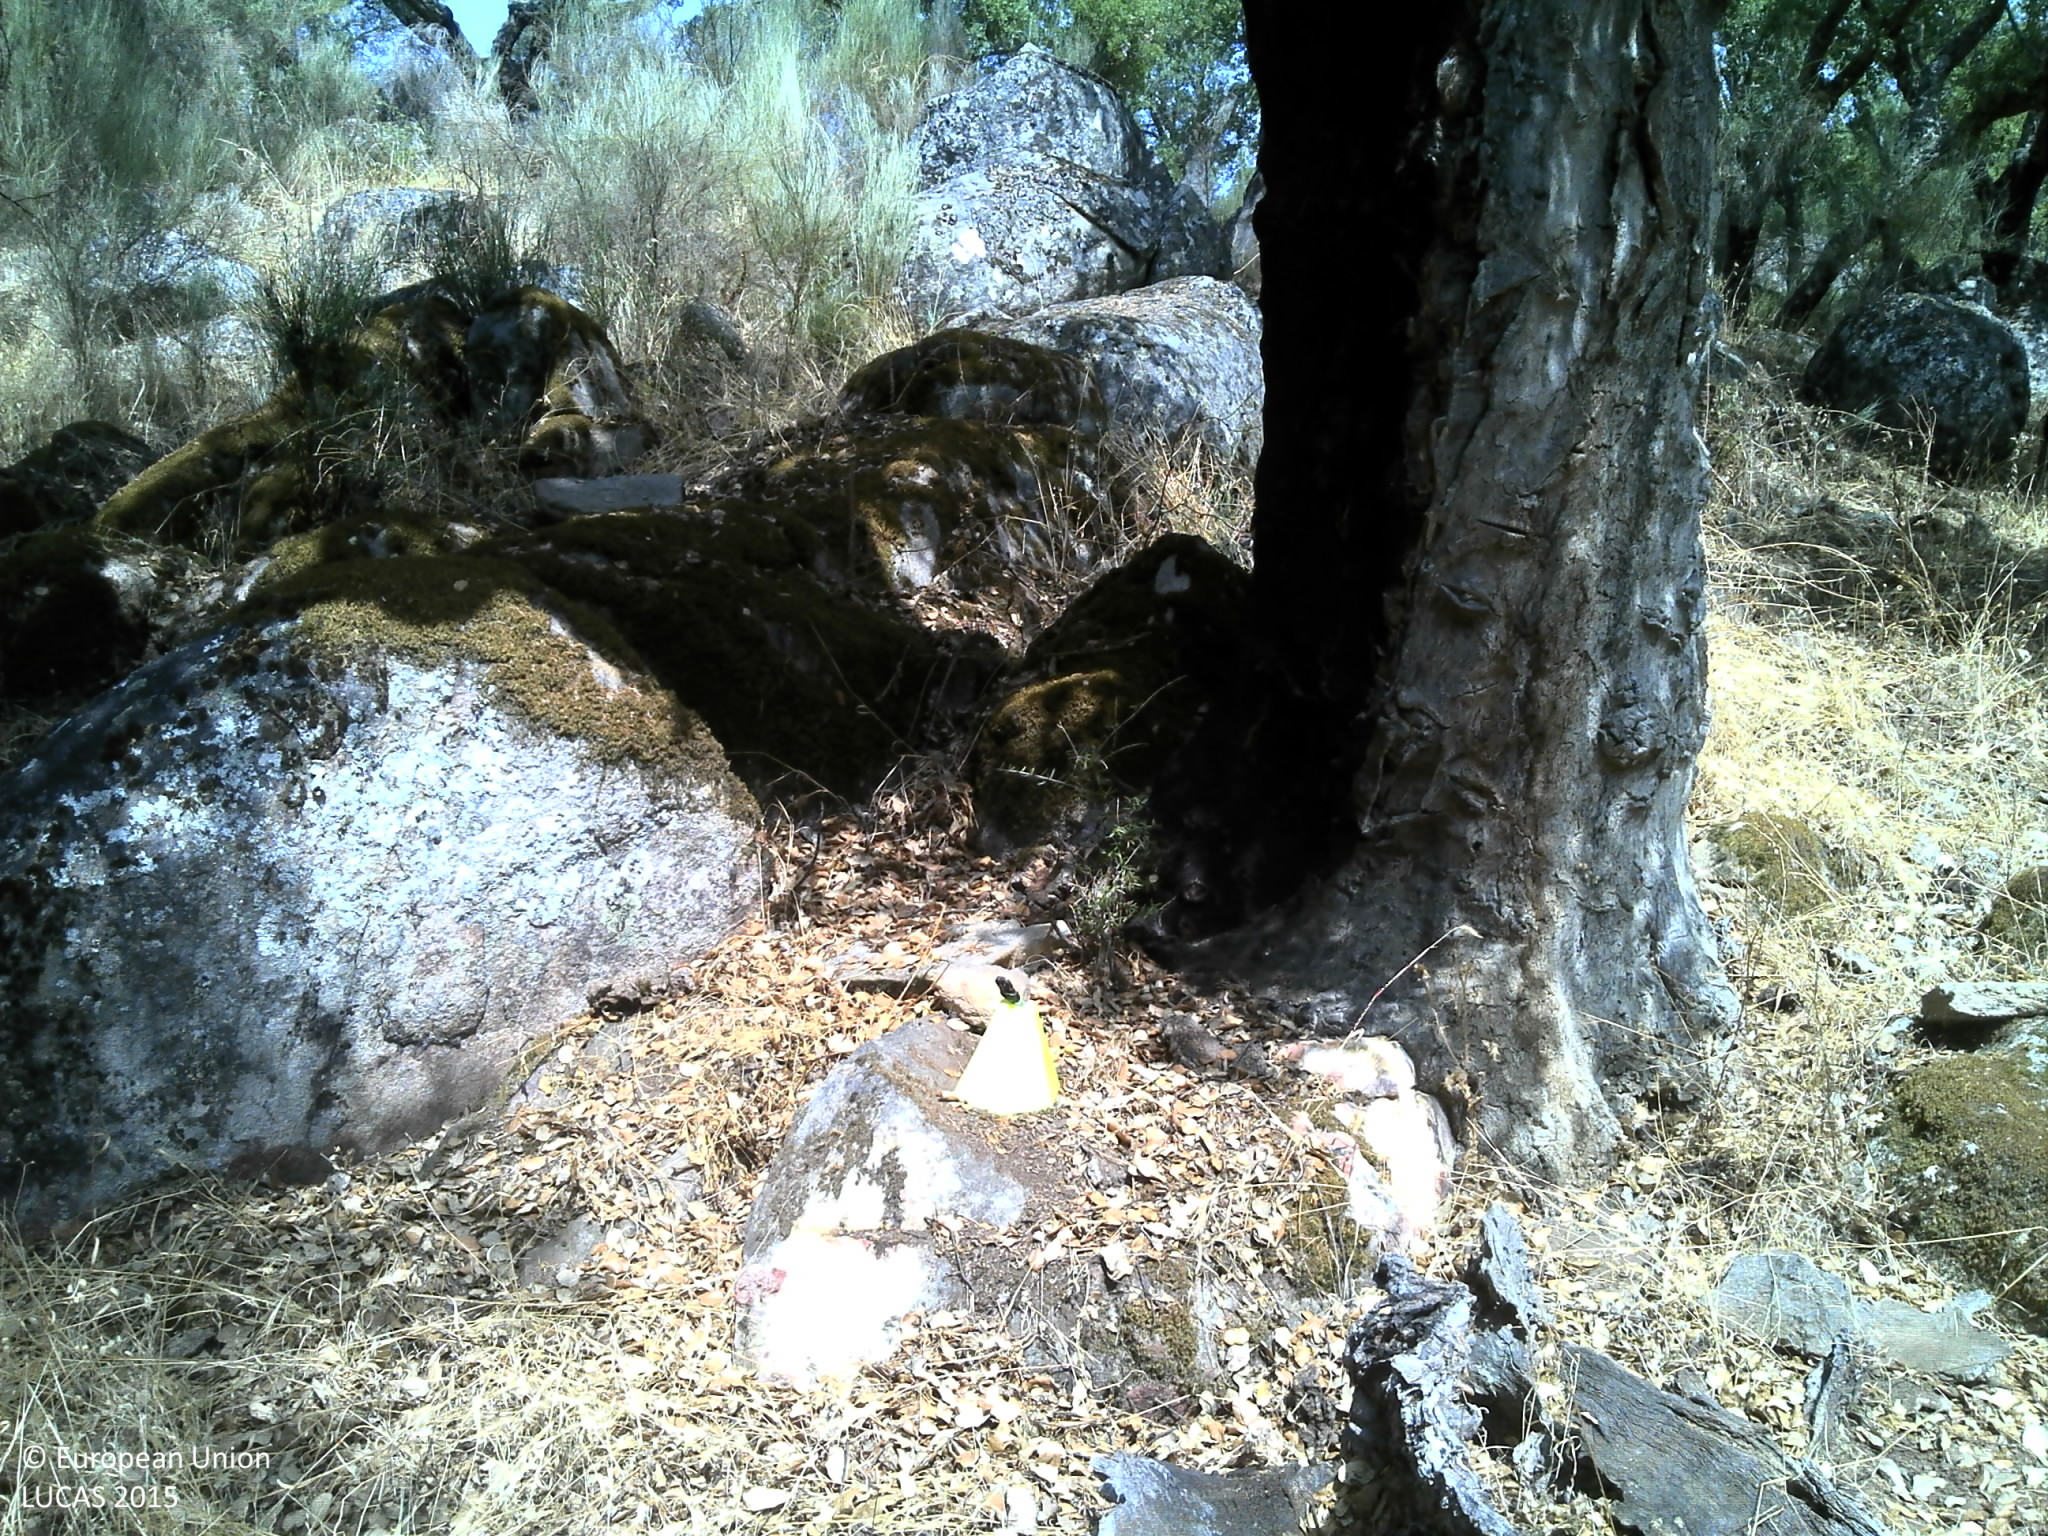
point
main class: Woodland
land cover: Broadleaved woodland
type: broadleaved evergreen forest
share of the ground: 25 - 50 %
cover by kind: broadleaved forest trees 50 %, consolidated bare surface 50 %
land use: Forestry
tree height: > 5 m
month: August
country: PT
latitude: 39.2778
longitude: -7.4650
